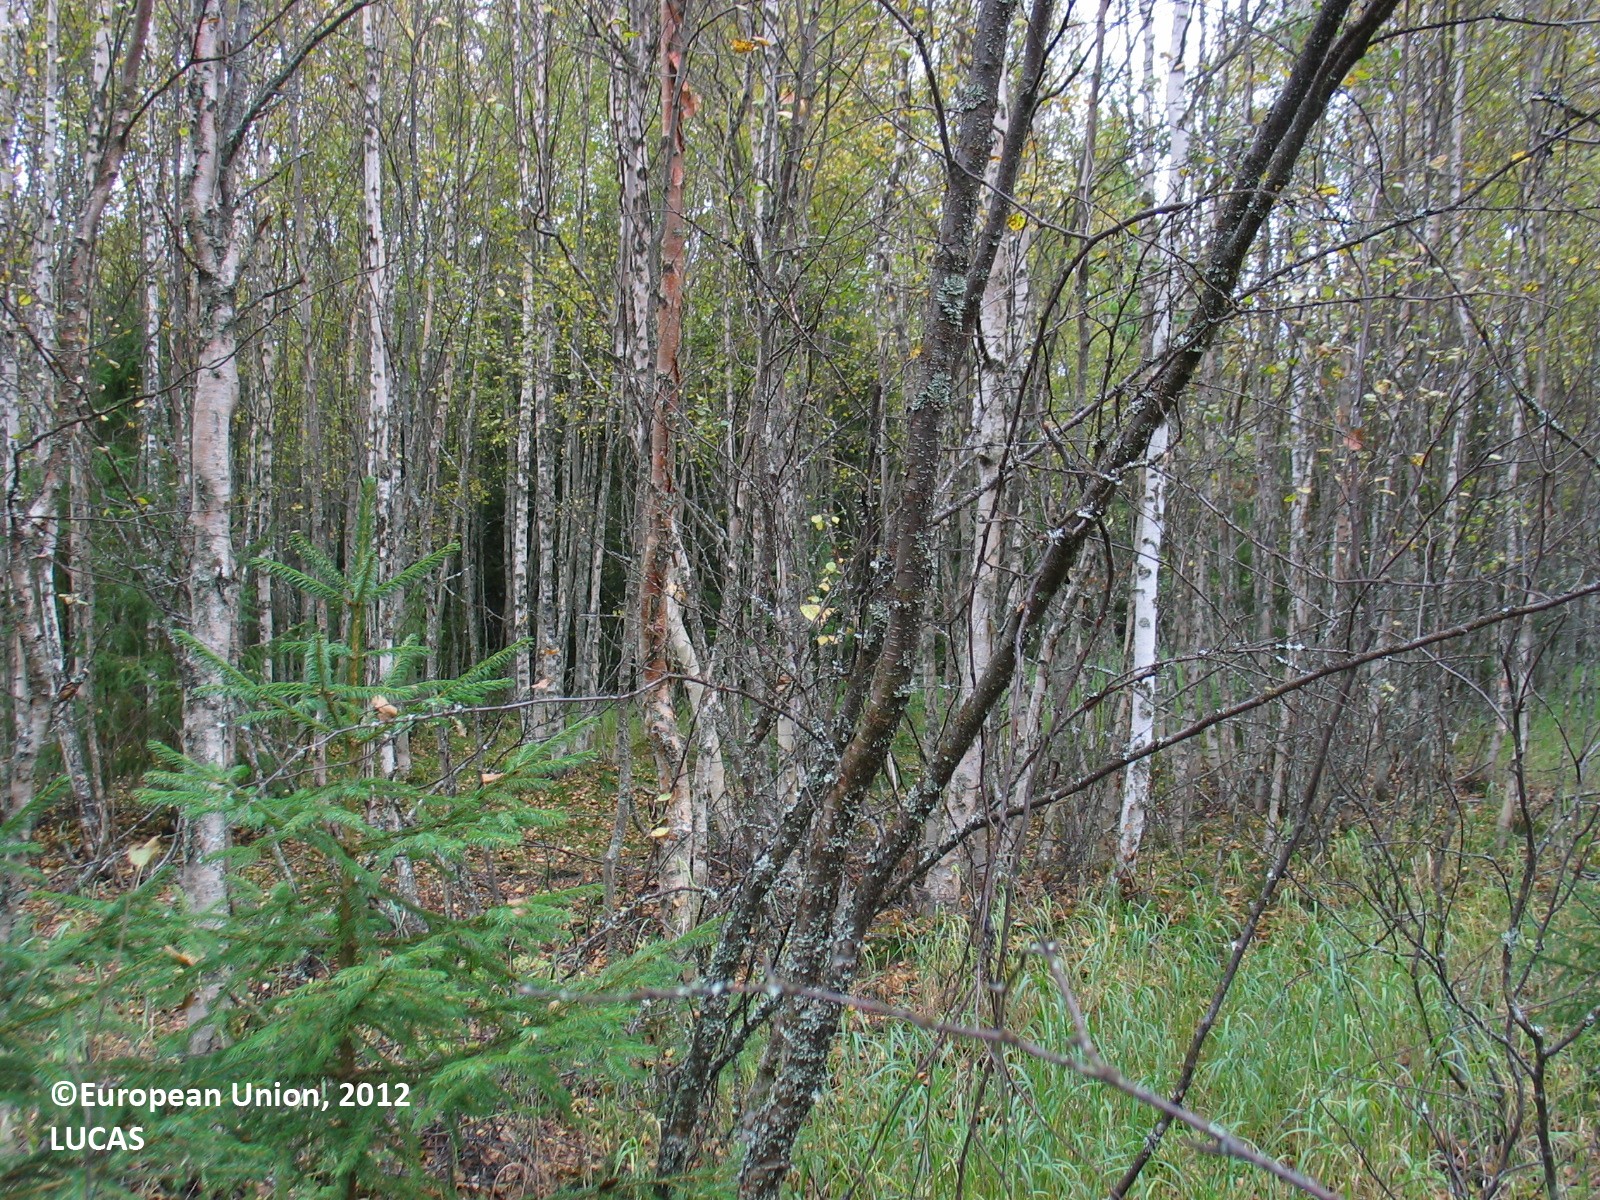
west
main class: Woodland
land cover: Broadleaved woodland
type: mire and swamp forests
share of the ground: 25 - 50 %
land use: Forestry
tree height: > 5 m
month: September
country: FI
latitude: 65.5702
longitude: 25.1289
